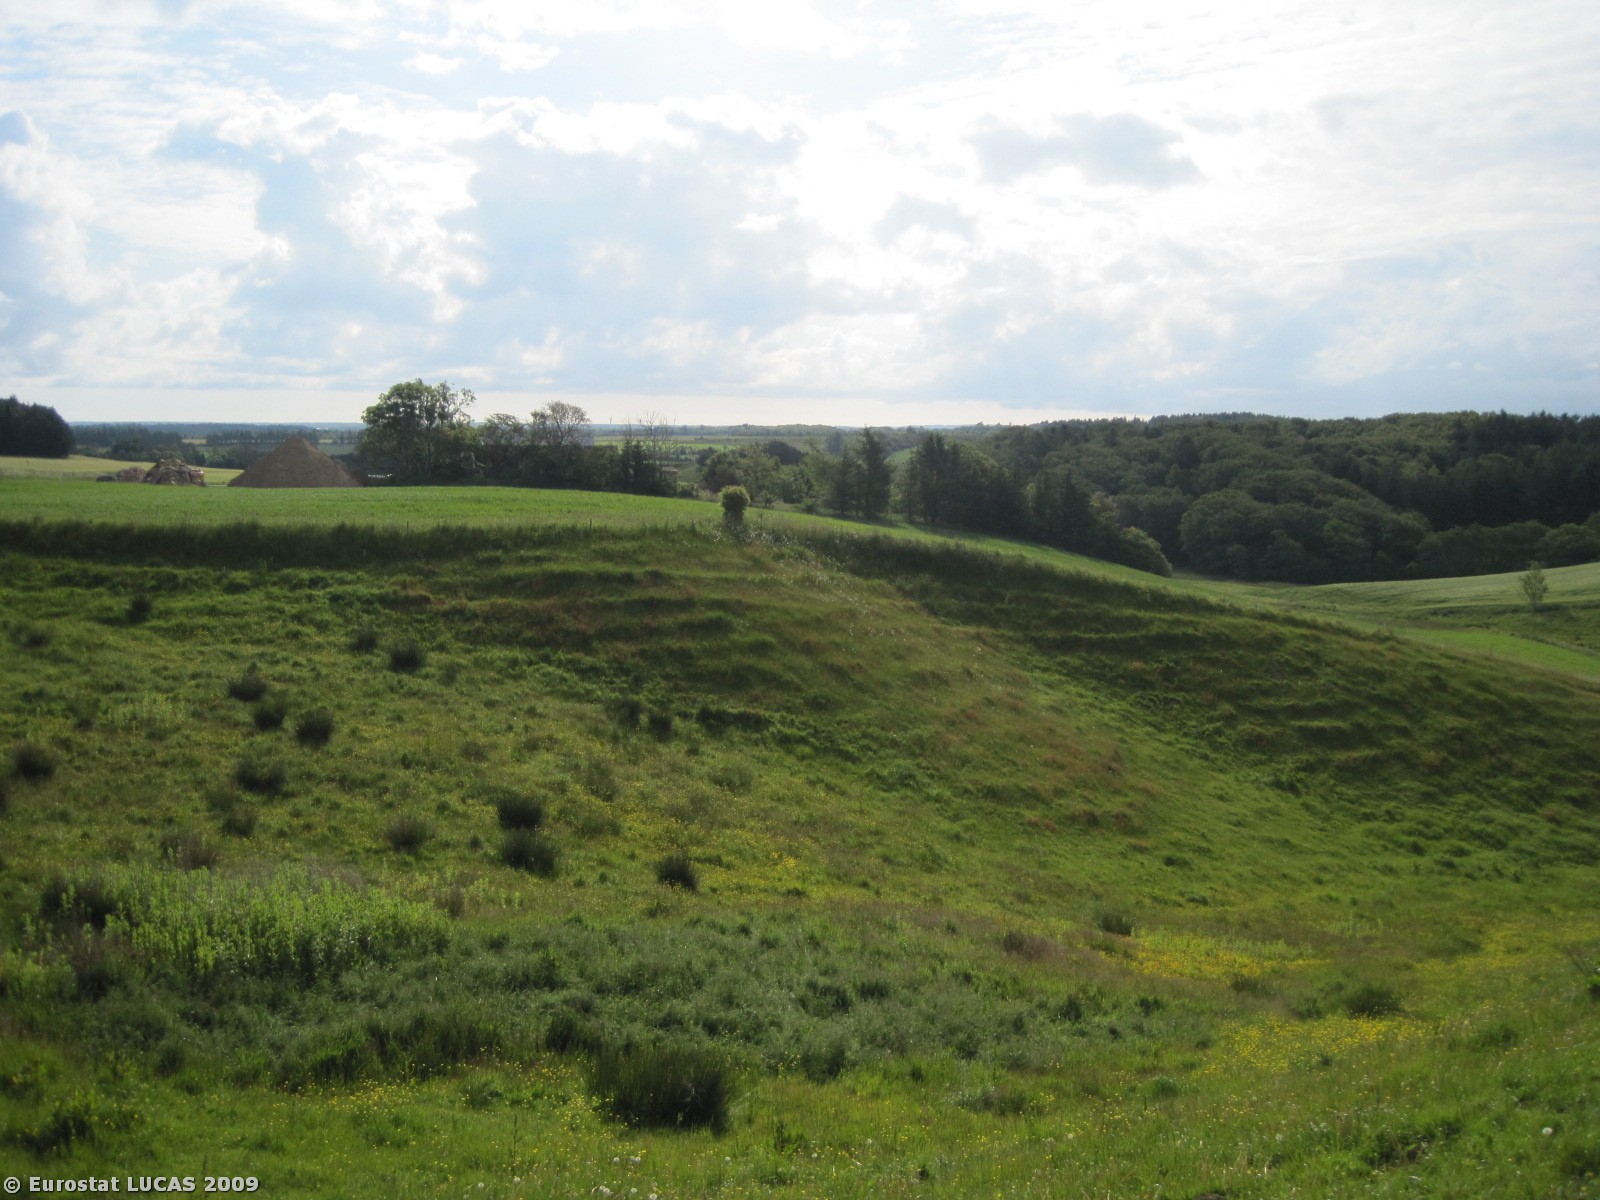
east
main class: Grassland
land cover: Grassland without tree/shrub cover
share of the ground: > 75 %
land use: Agriculture (excluding fallow land and kitchen gardens)
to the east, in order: Grassland without tree/shrub cover; Fences; Grassland without tree/shrub cover; Fences; Common wheat; Shrubland with sparse tree cover; Broadleaved woodland; Grassland without tree/shrub cover; Bare land; Barley
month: June
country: DK
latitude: 57.5361
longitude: 10.0500
